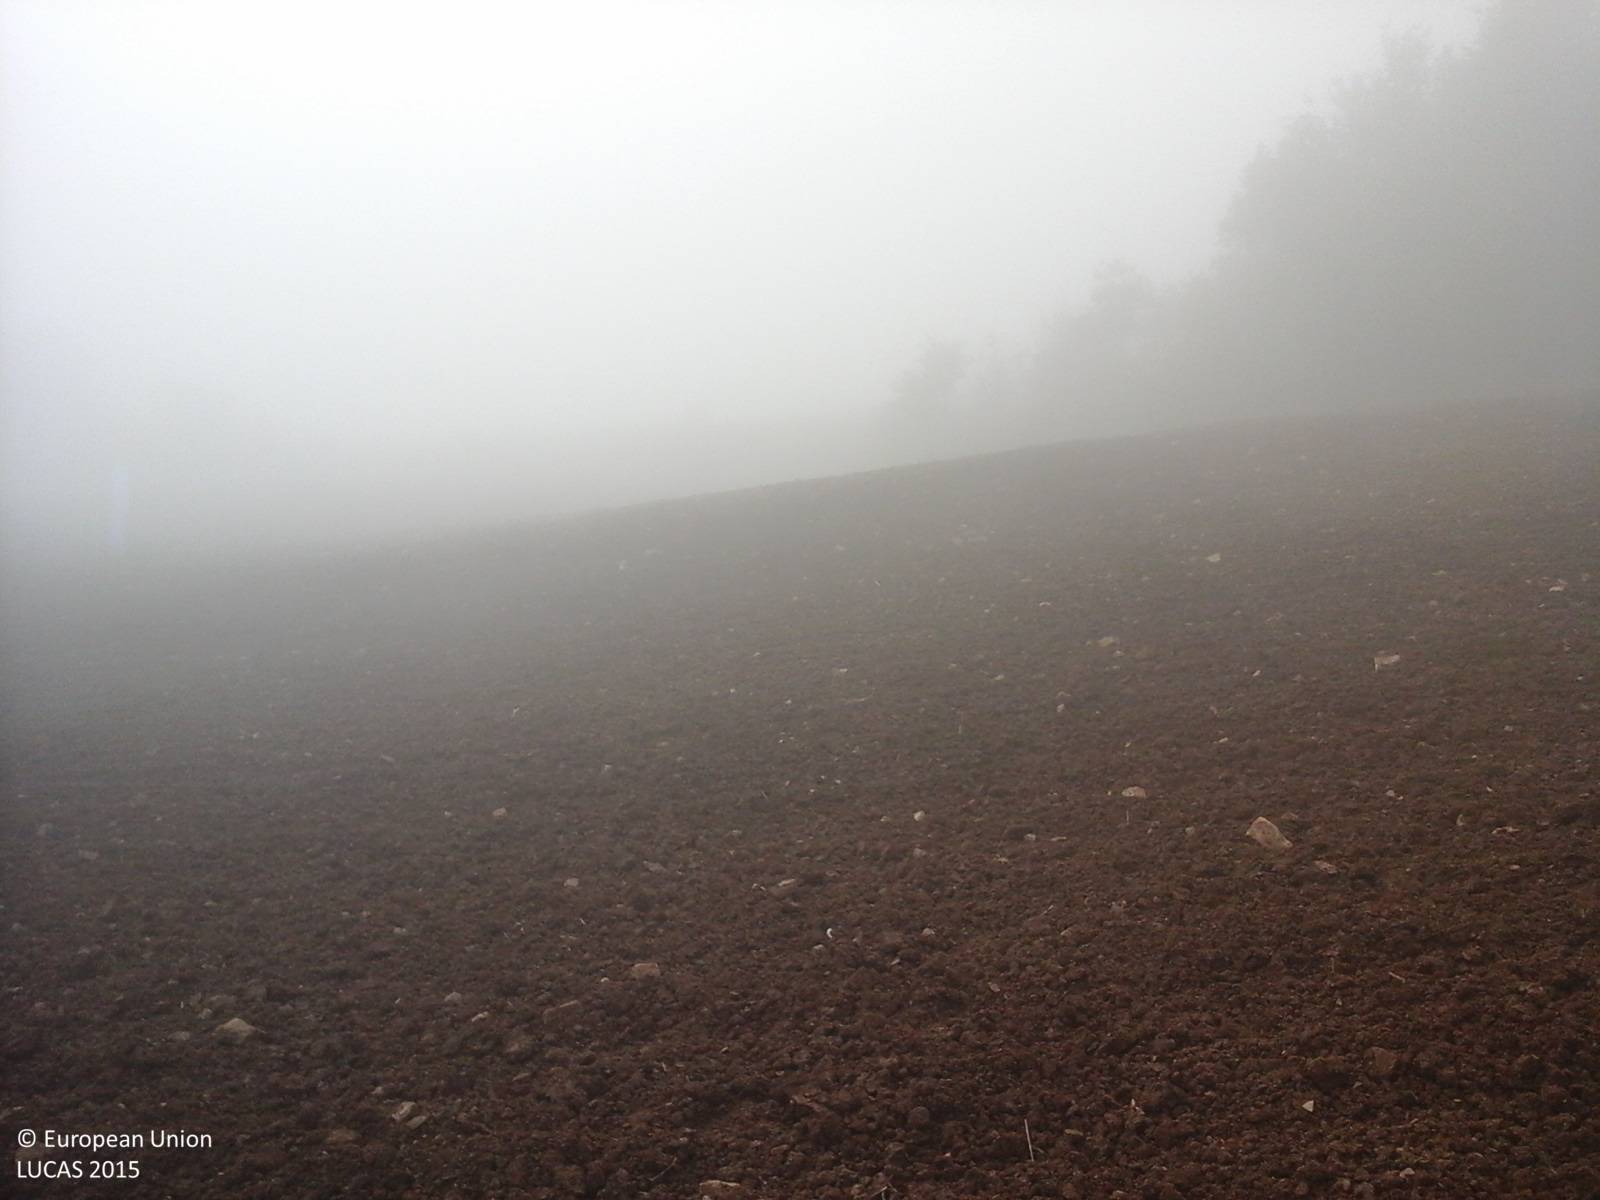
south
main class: Cropland
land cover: Oats
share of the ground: < 10 %
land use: Agriculture (excluding fallow land and kitchen gardens)
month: October
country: IT
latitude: 42.7718
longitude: 12.3270
